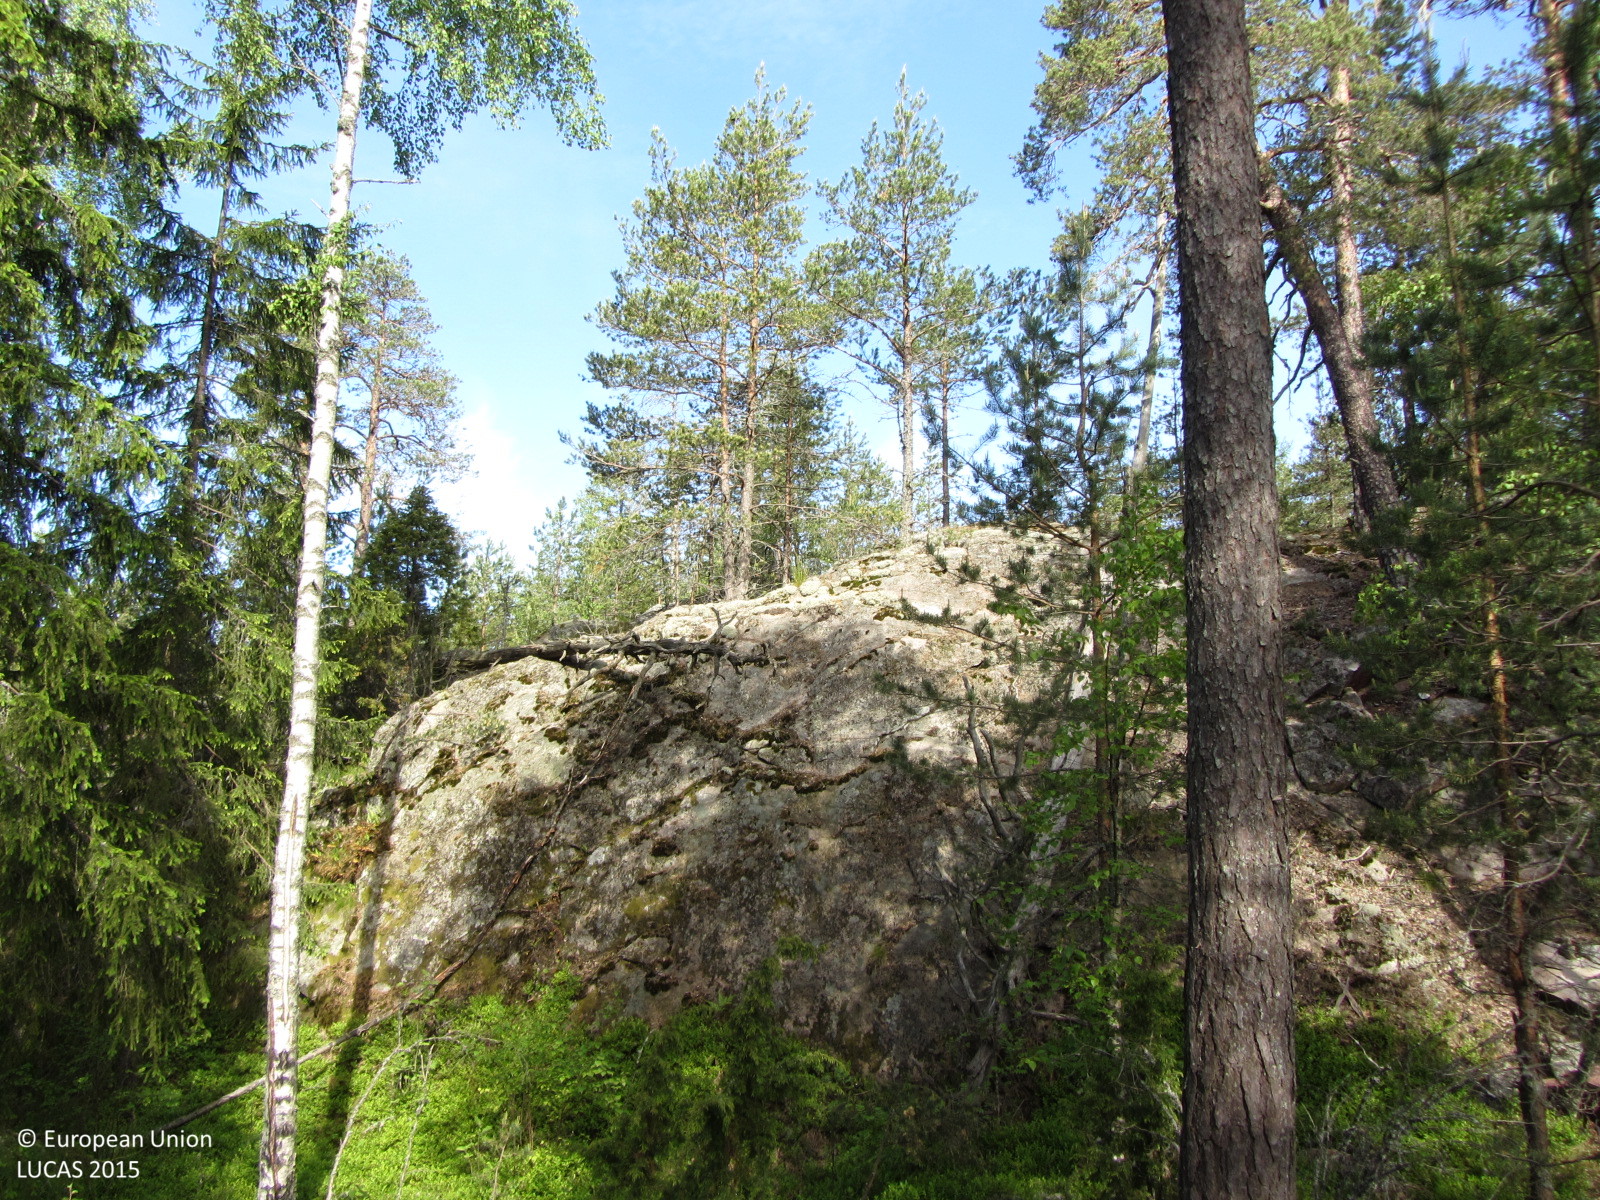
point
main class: Woodland
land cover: Pine dominated mixed woodland
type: boreal forest
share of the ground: 50 - 75 %
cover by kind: coniferous forest trees 30 %, consolidated bare surface 30 %, broadleaved forest trees 20 %, shrubs 10 %, herbaceous plants 10 %
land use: Forestry
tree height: > 5 m
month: June
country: FI
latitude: 60.1495
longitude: 24.2424
